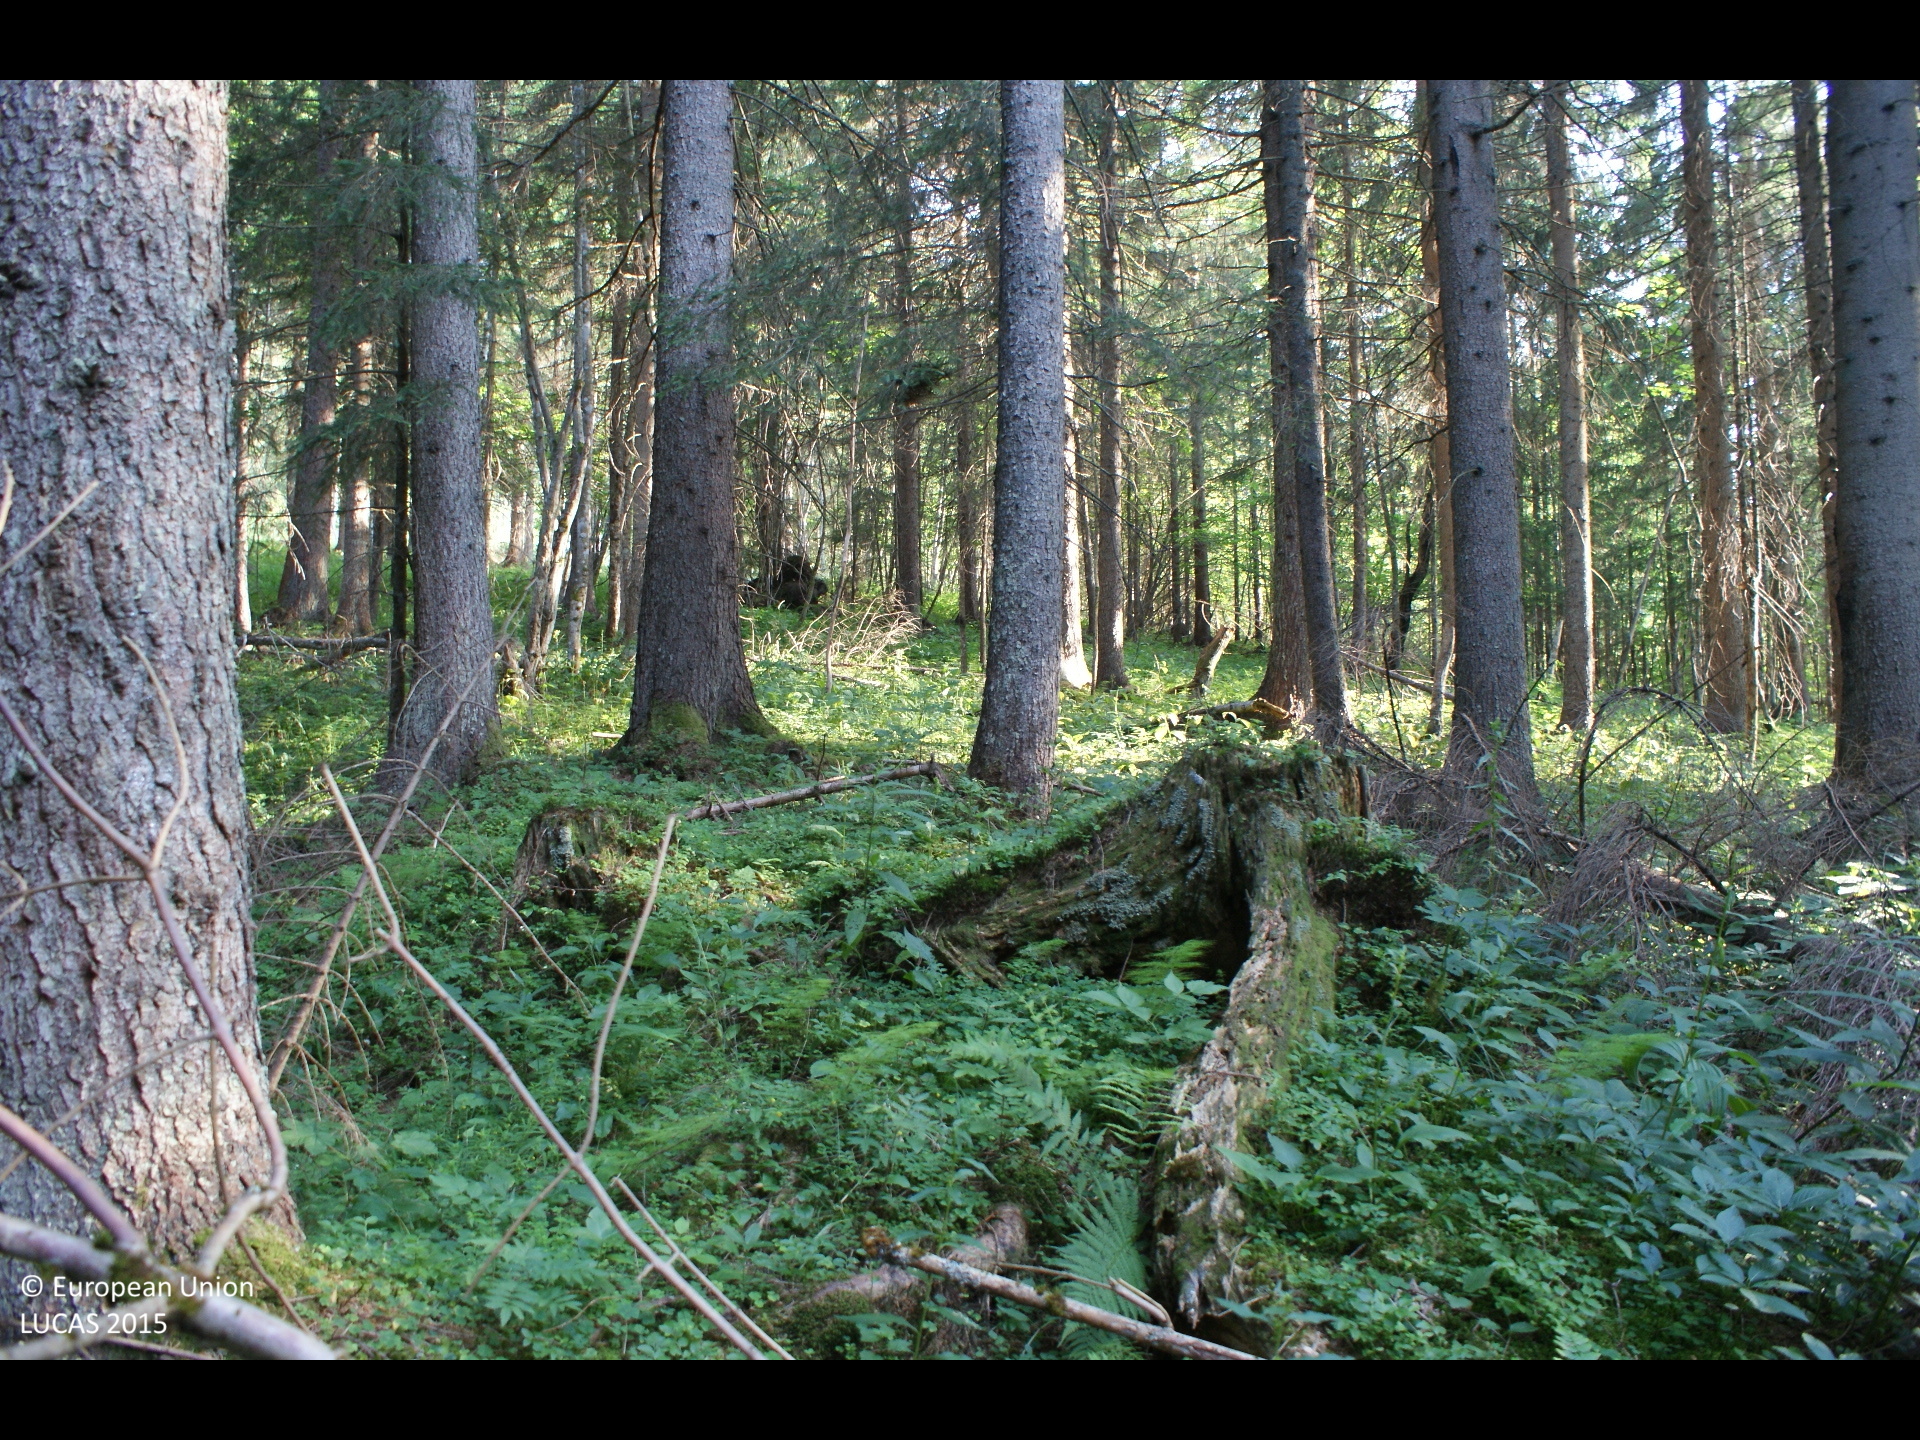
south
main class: Woodland
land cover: Spruce dominated mixed woodland
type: mesophytic deciduous forest
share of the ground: > 75 %
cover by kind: coniferous forest trees 65 %, broadleaved forest trees 25 %, herbaceous plants 10 %
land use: Forestry
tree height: > 5 m
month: July
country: AT
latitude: 47.7650
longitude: 15.4316
